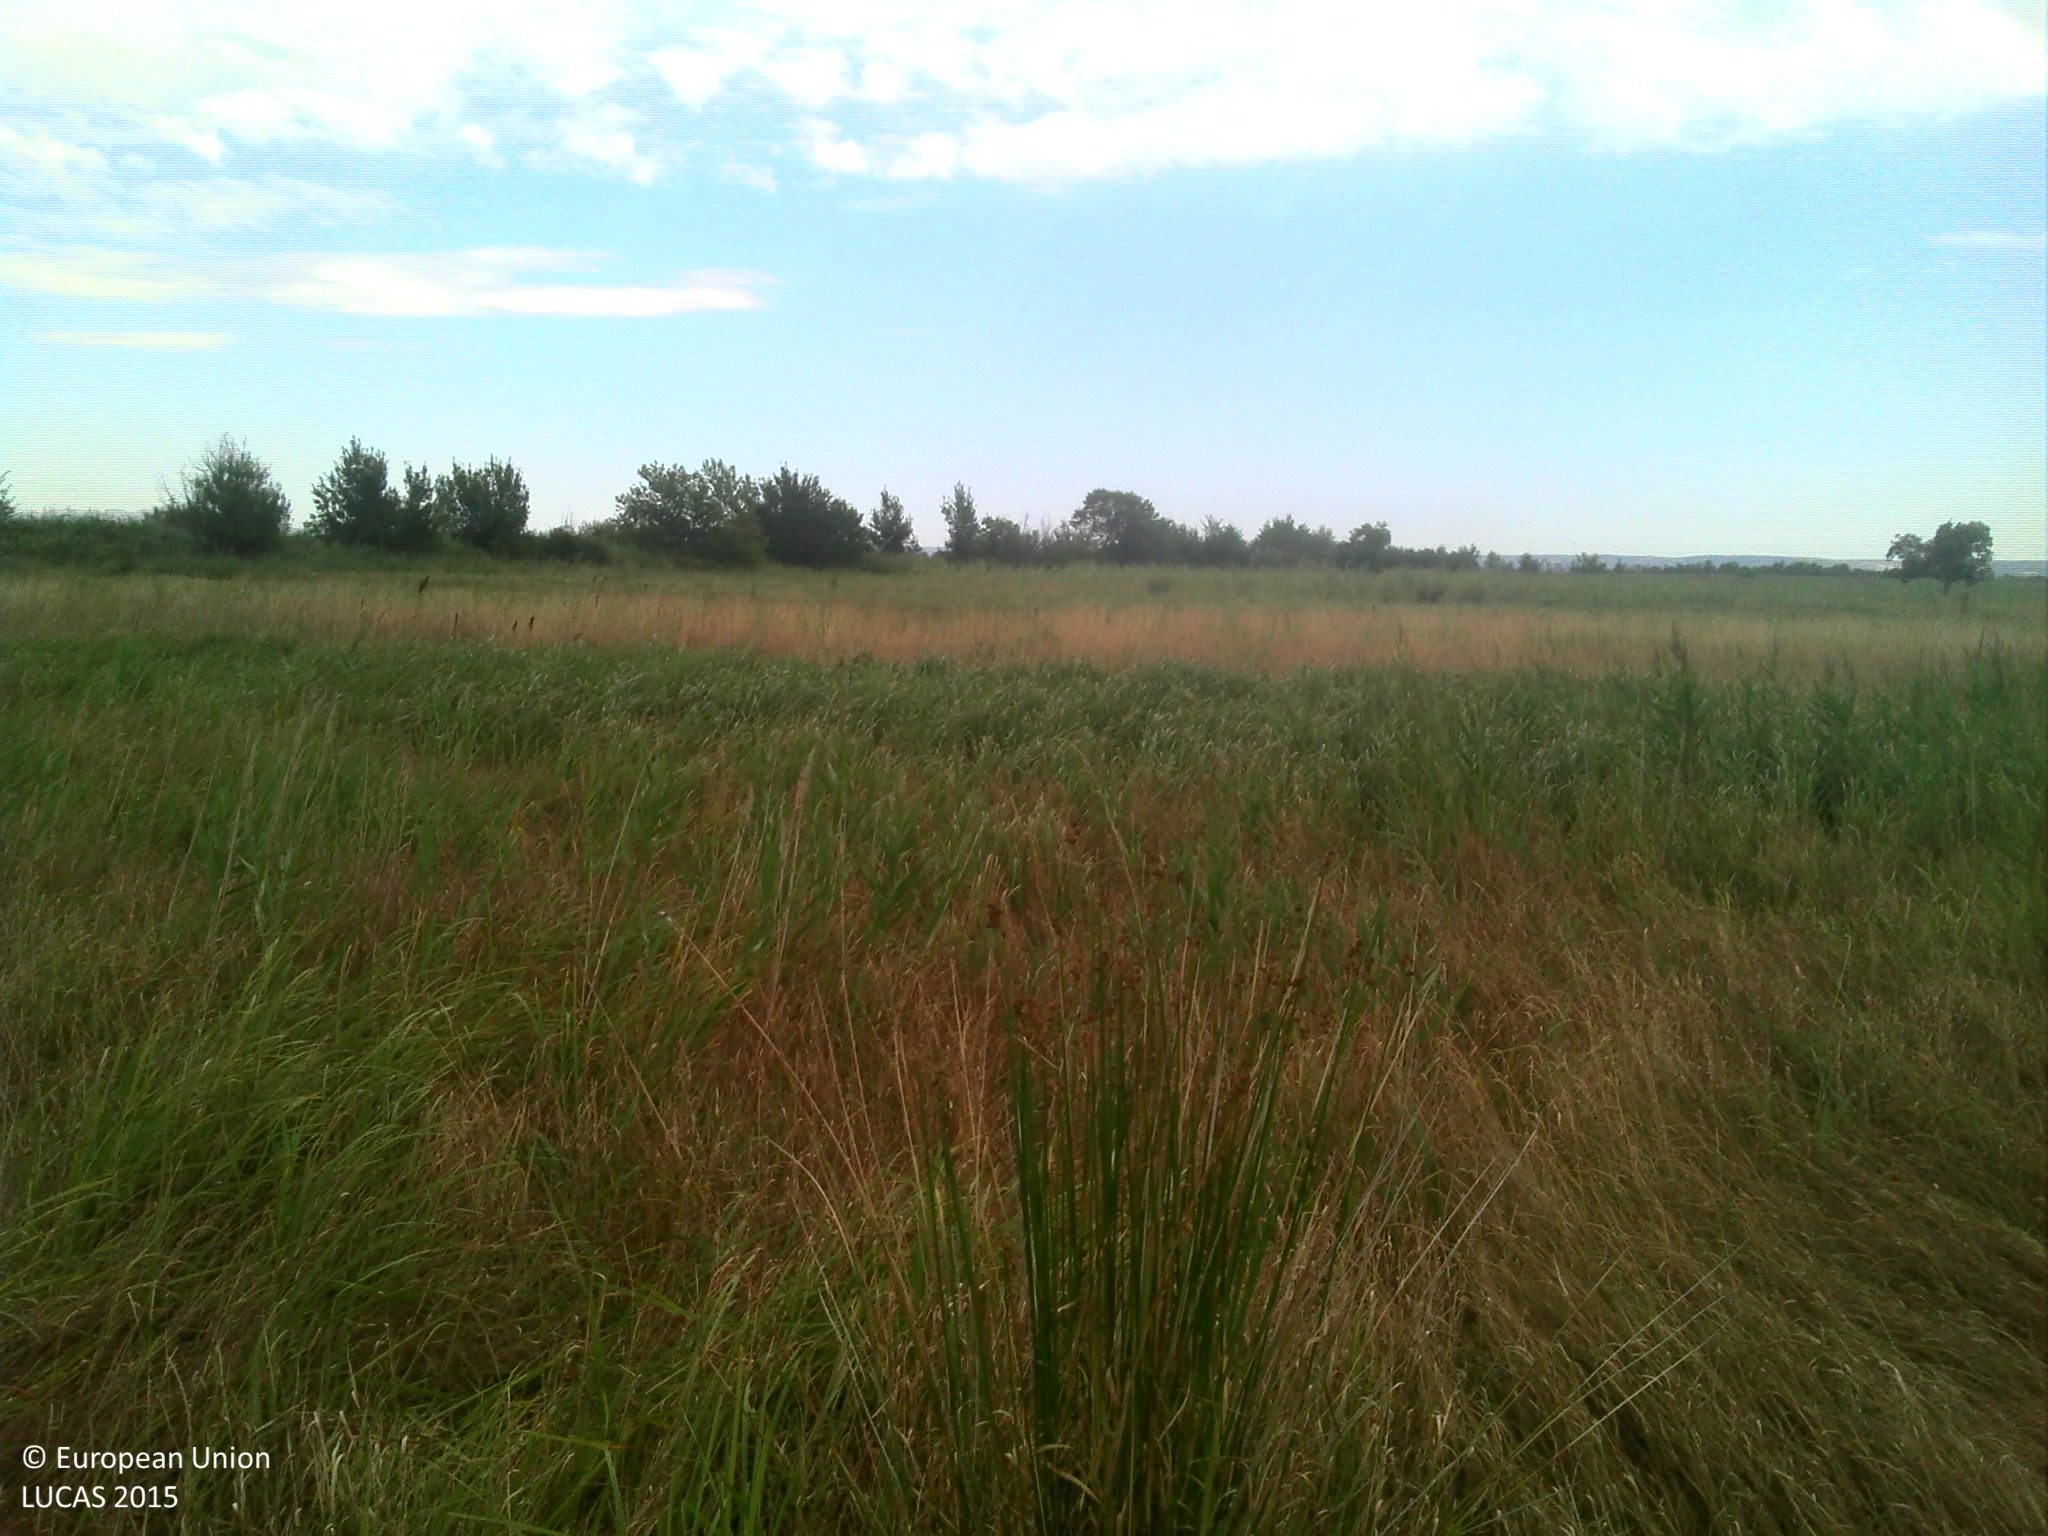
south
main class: Grassland
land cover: Grassland without tree/shrub cover
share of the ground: > 75 %
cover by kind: herbaceous plants 95 %, shrubs 5 %
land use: Semi-natural and natural areas not in use
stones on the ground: < 10 %
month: July
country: FR
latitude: 43.5275
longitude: 5.0483
